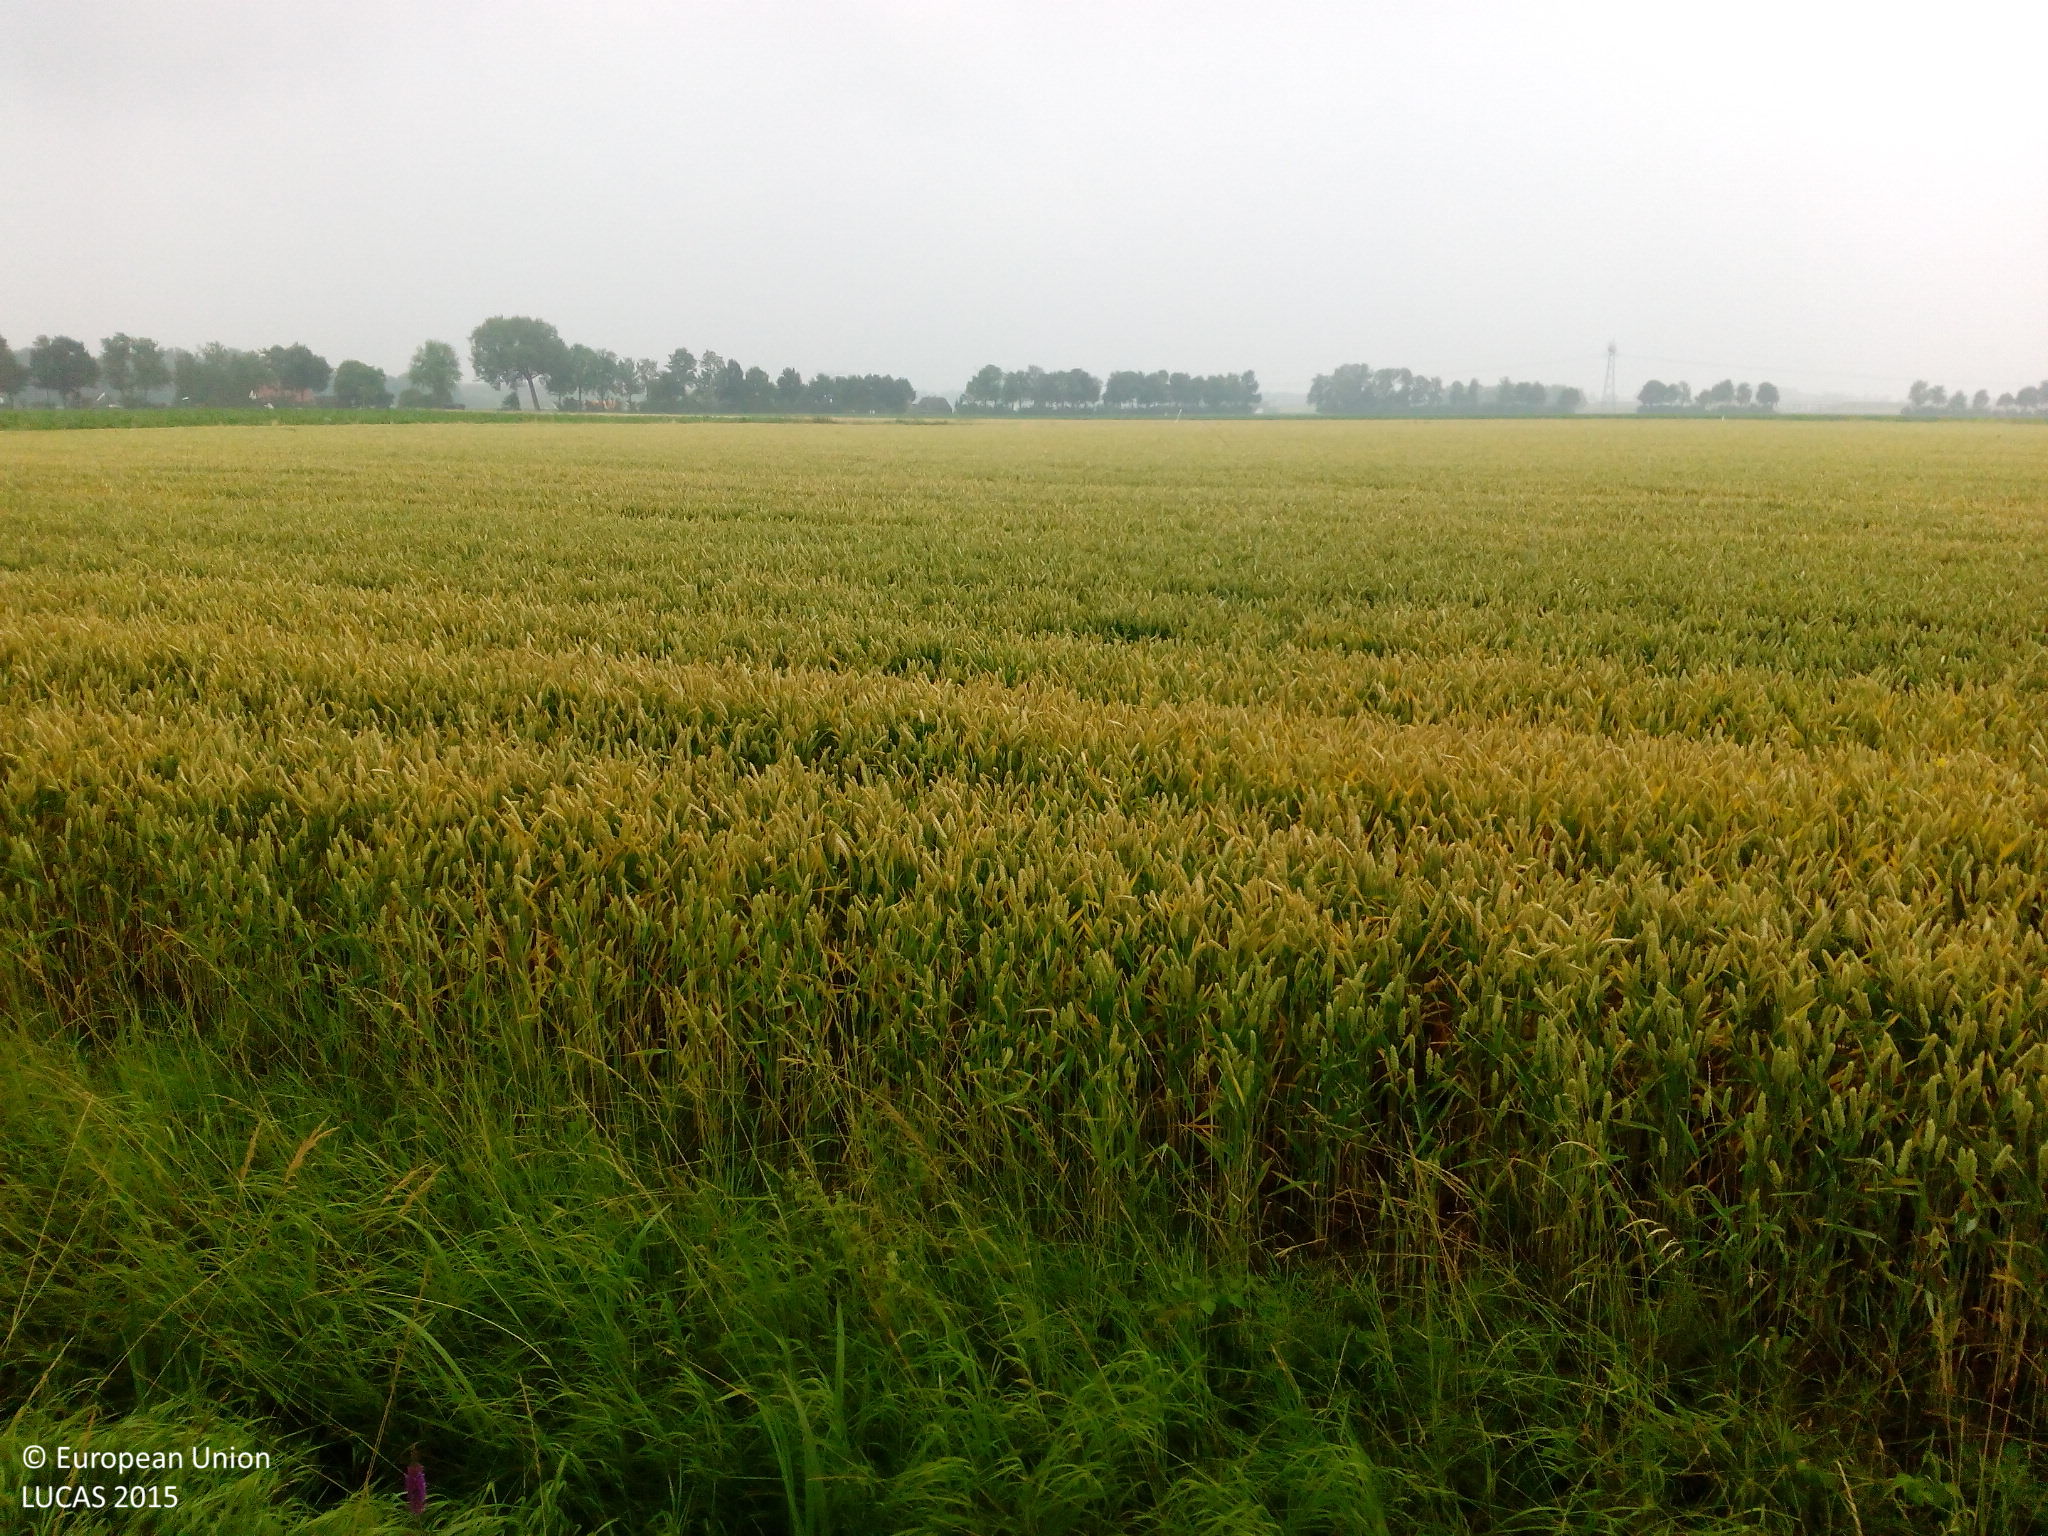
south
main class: Cropland
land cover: Common wheat
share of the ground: > 75 %
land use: Agriculture (excluding fallow land and kitchen gardens)
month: July
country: NL
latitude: 51.8681
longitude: 5.7143
